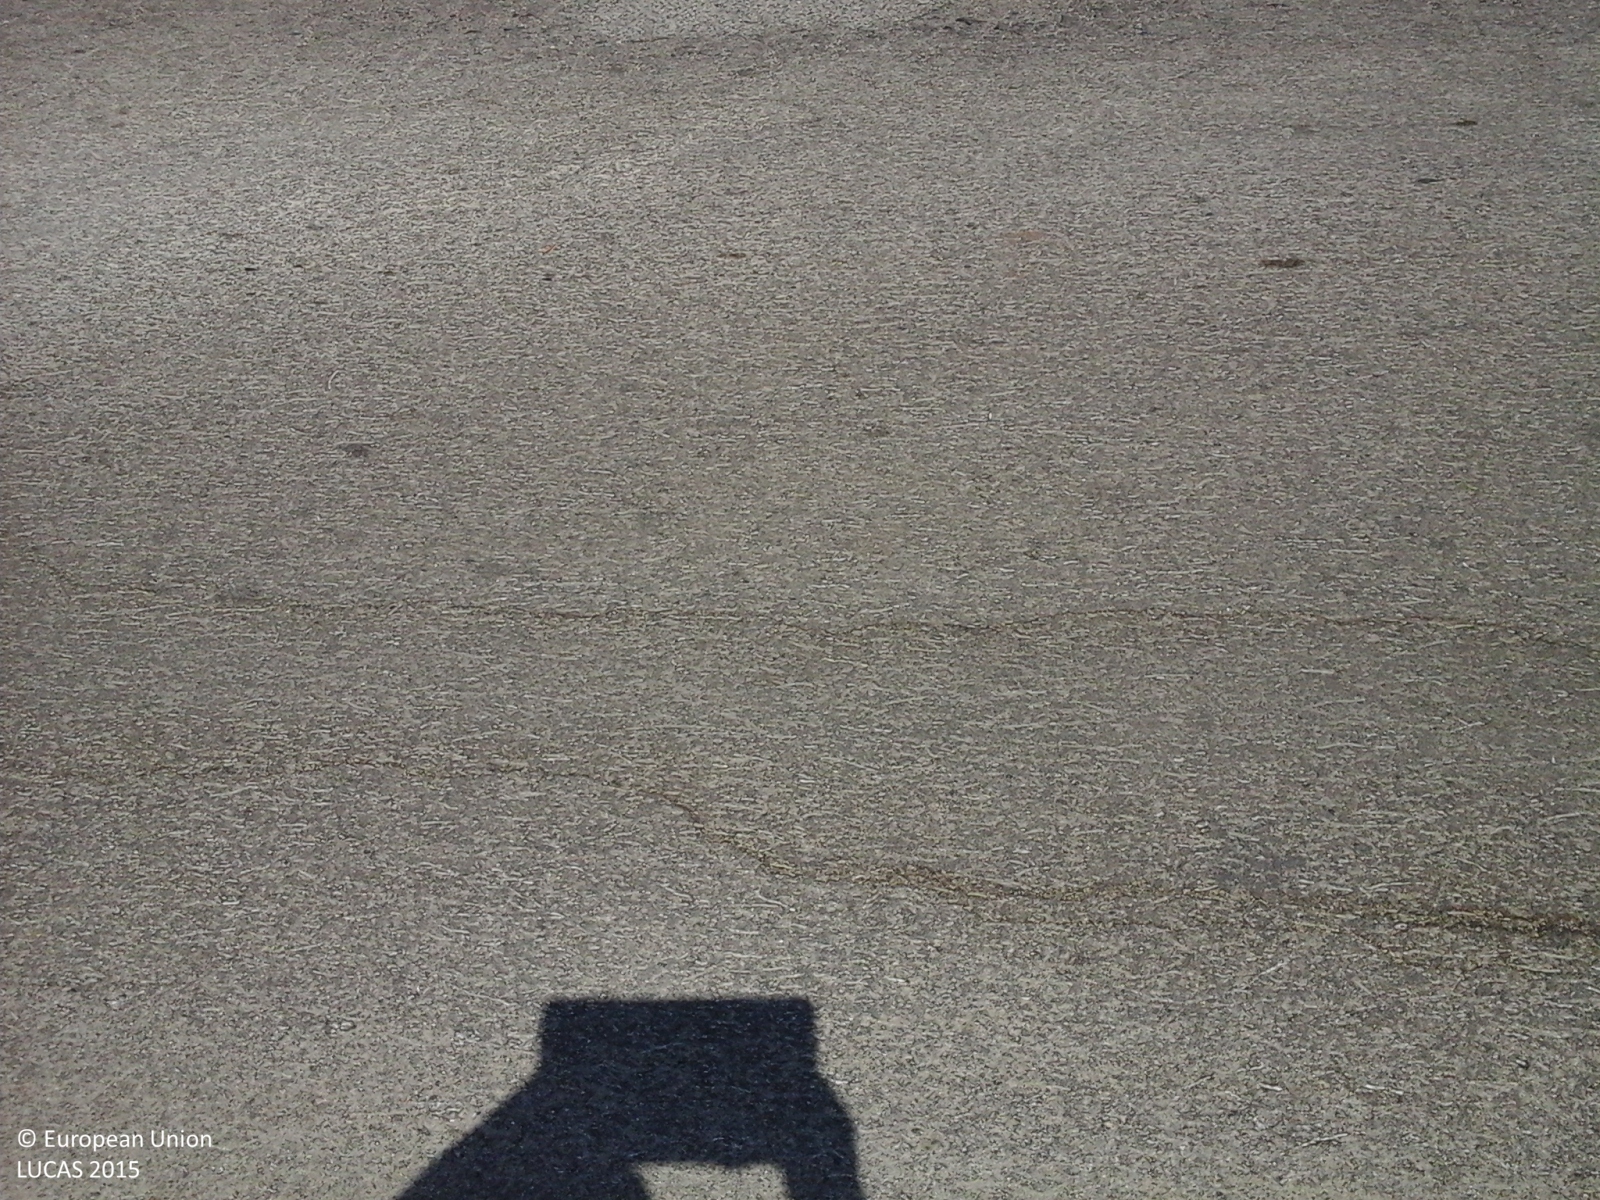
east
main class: Cropland
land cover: Durum wheat
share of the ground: > 75 %
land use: Agriculture (excluding fallow land and kitchen gardens)
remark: Burnt area
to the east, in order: Durum wheat; Grass margins; Artificial constructions in urban areas; Grassland without tree/shrub cover; Olive groves; Artificial constructions in urban areas; Olive groves; Electric lines; Olive groves; Fences; Tracks; Fences; Olive groves; Fences; Tracks; Fences; Olive groves
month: July
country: IT
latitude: 37.1541
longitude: 14.4133
